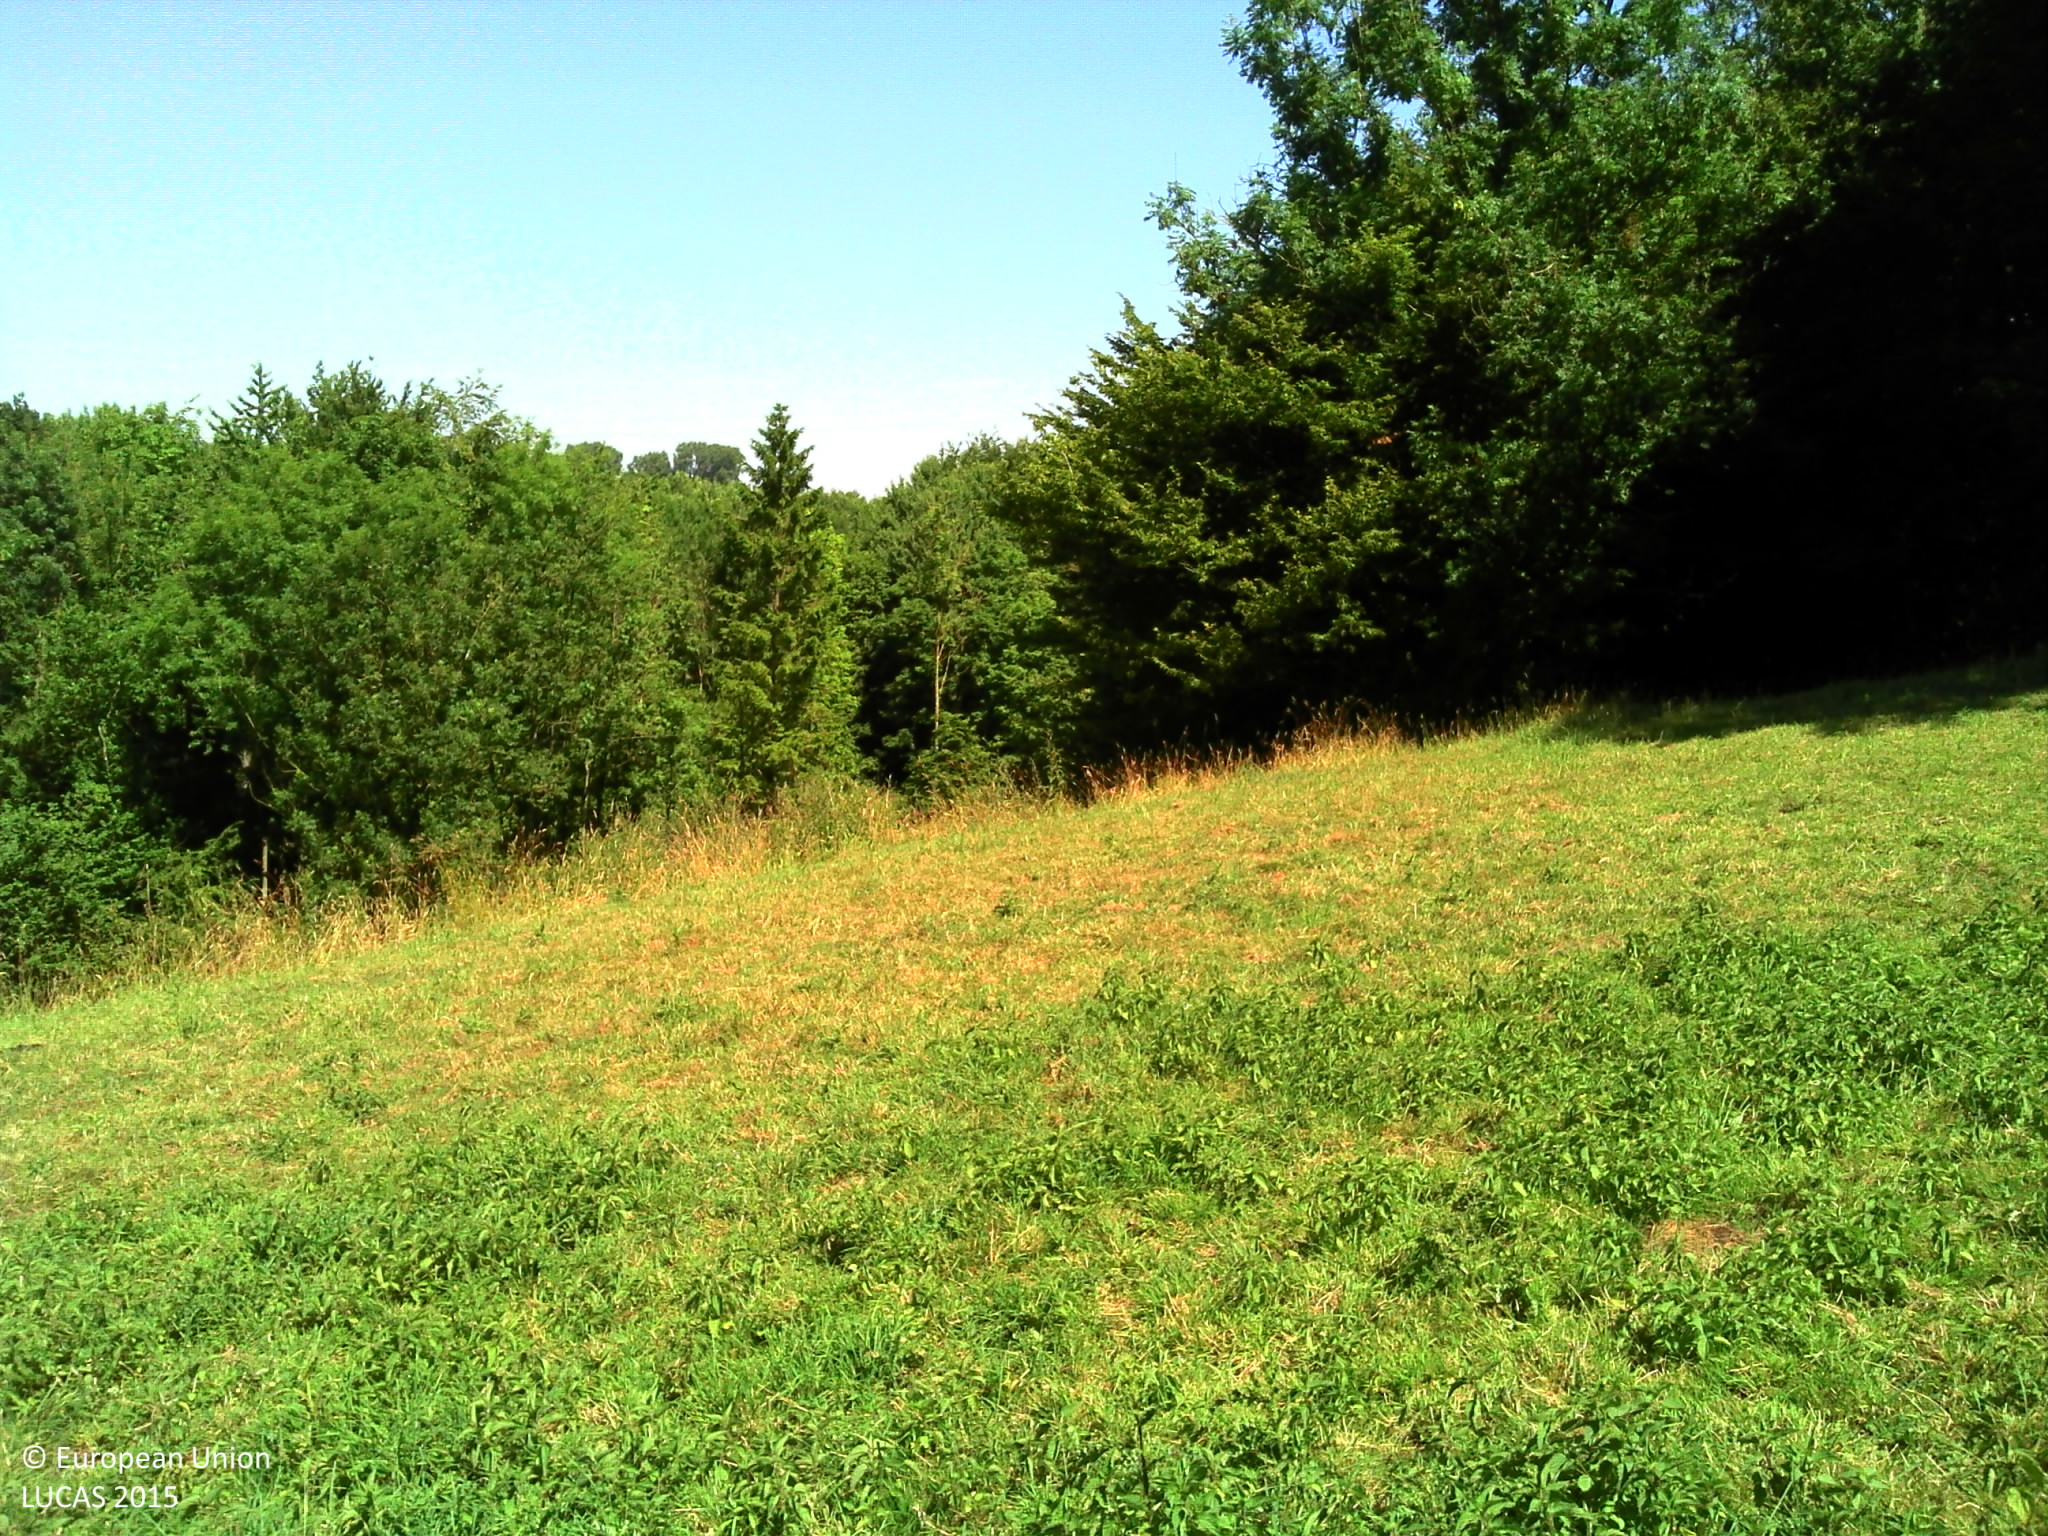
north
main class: Grassland
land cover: Grassland without tree/shrub cover
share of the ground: > 75 %
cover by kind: herbaceous plants 95 %
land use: Agriculture (excluding fallow land and kitchen gardens)
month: July
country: FR
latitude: 50.3258
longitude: 2.1049
